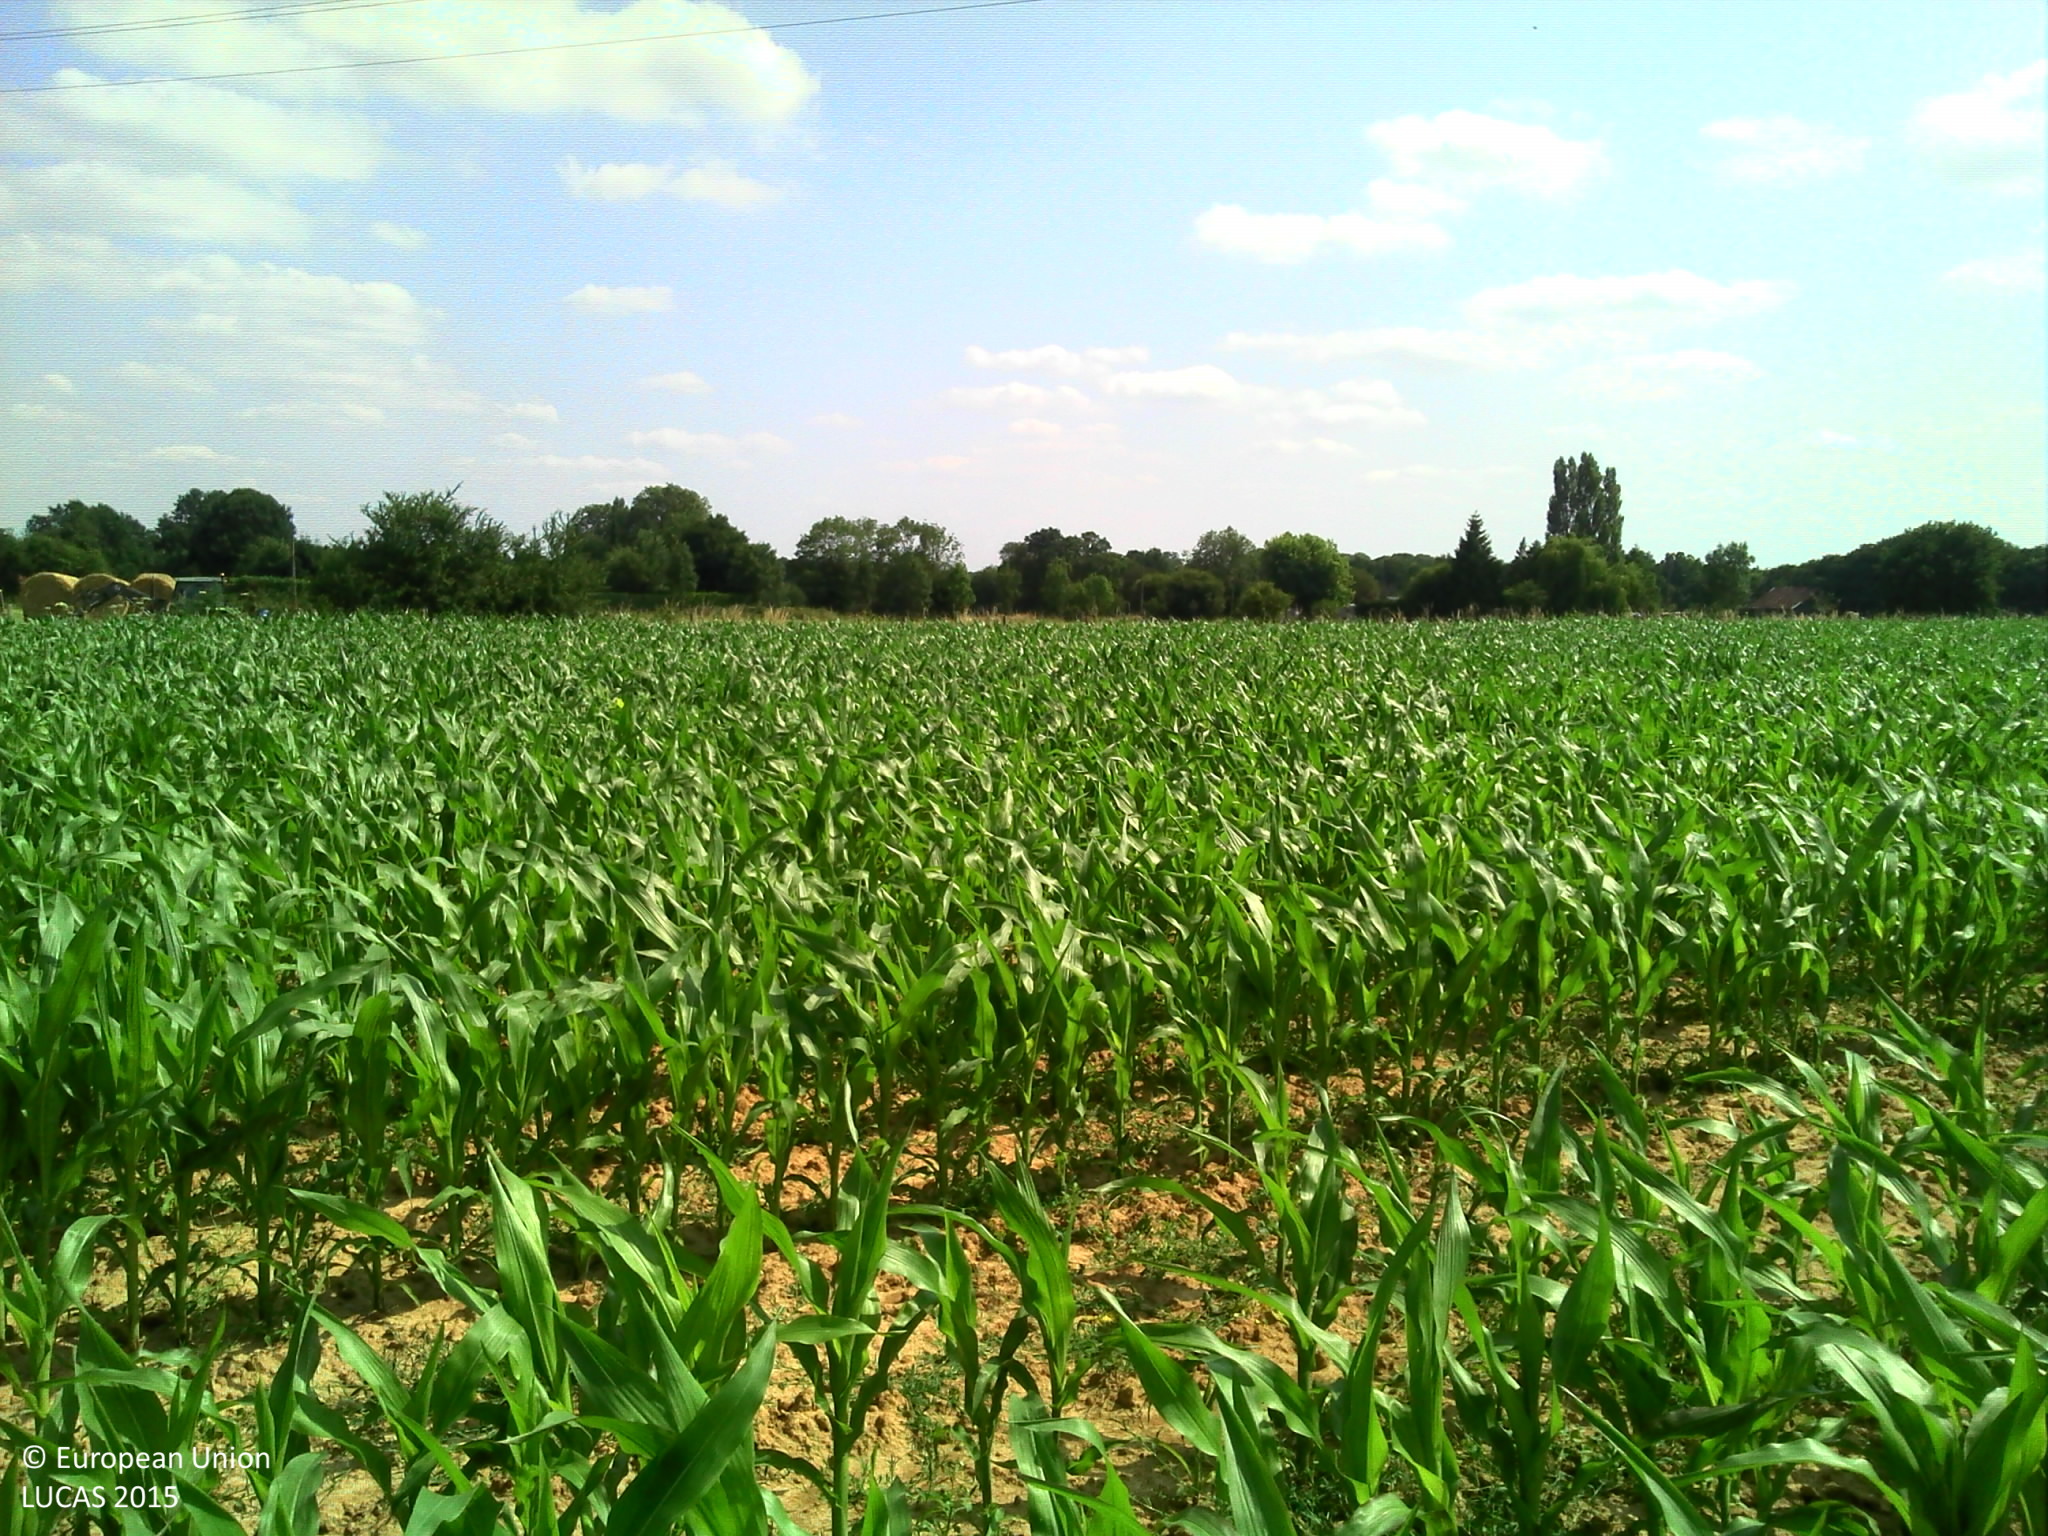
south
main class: Cropland
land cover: Maize
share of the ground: 25 - 50 %
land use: Agriculture (excluding fallow land and kitchen gardens)
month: July
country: FR
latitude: 49.2023
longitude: 0.6561
